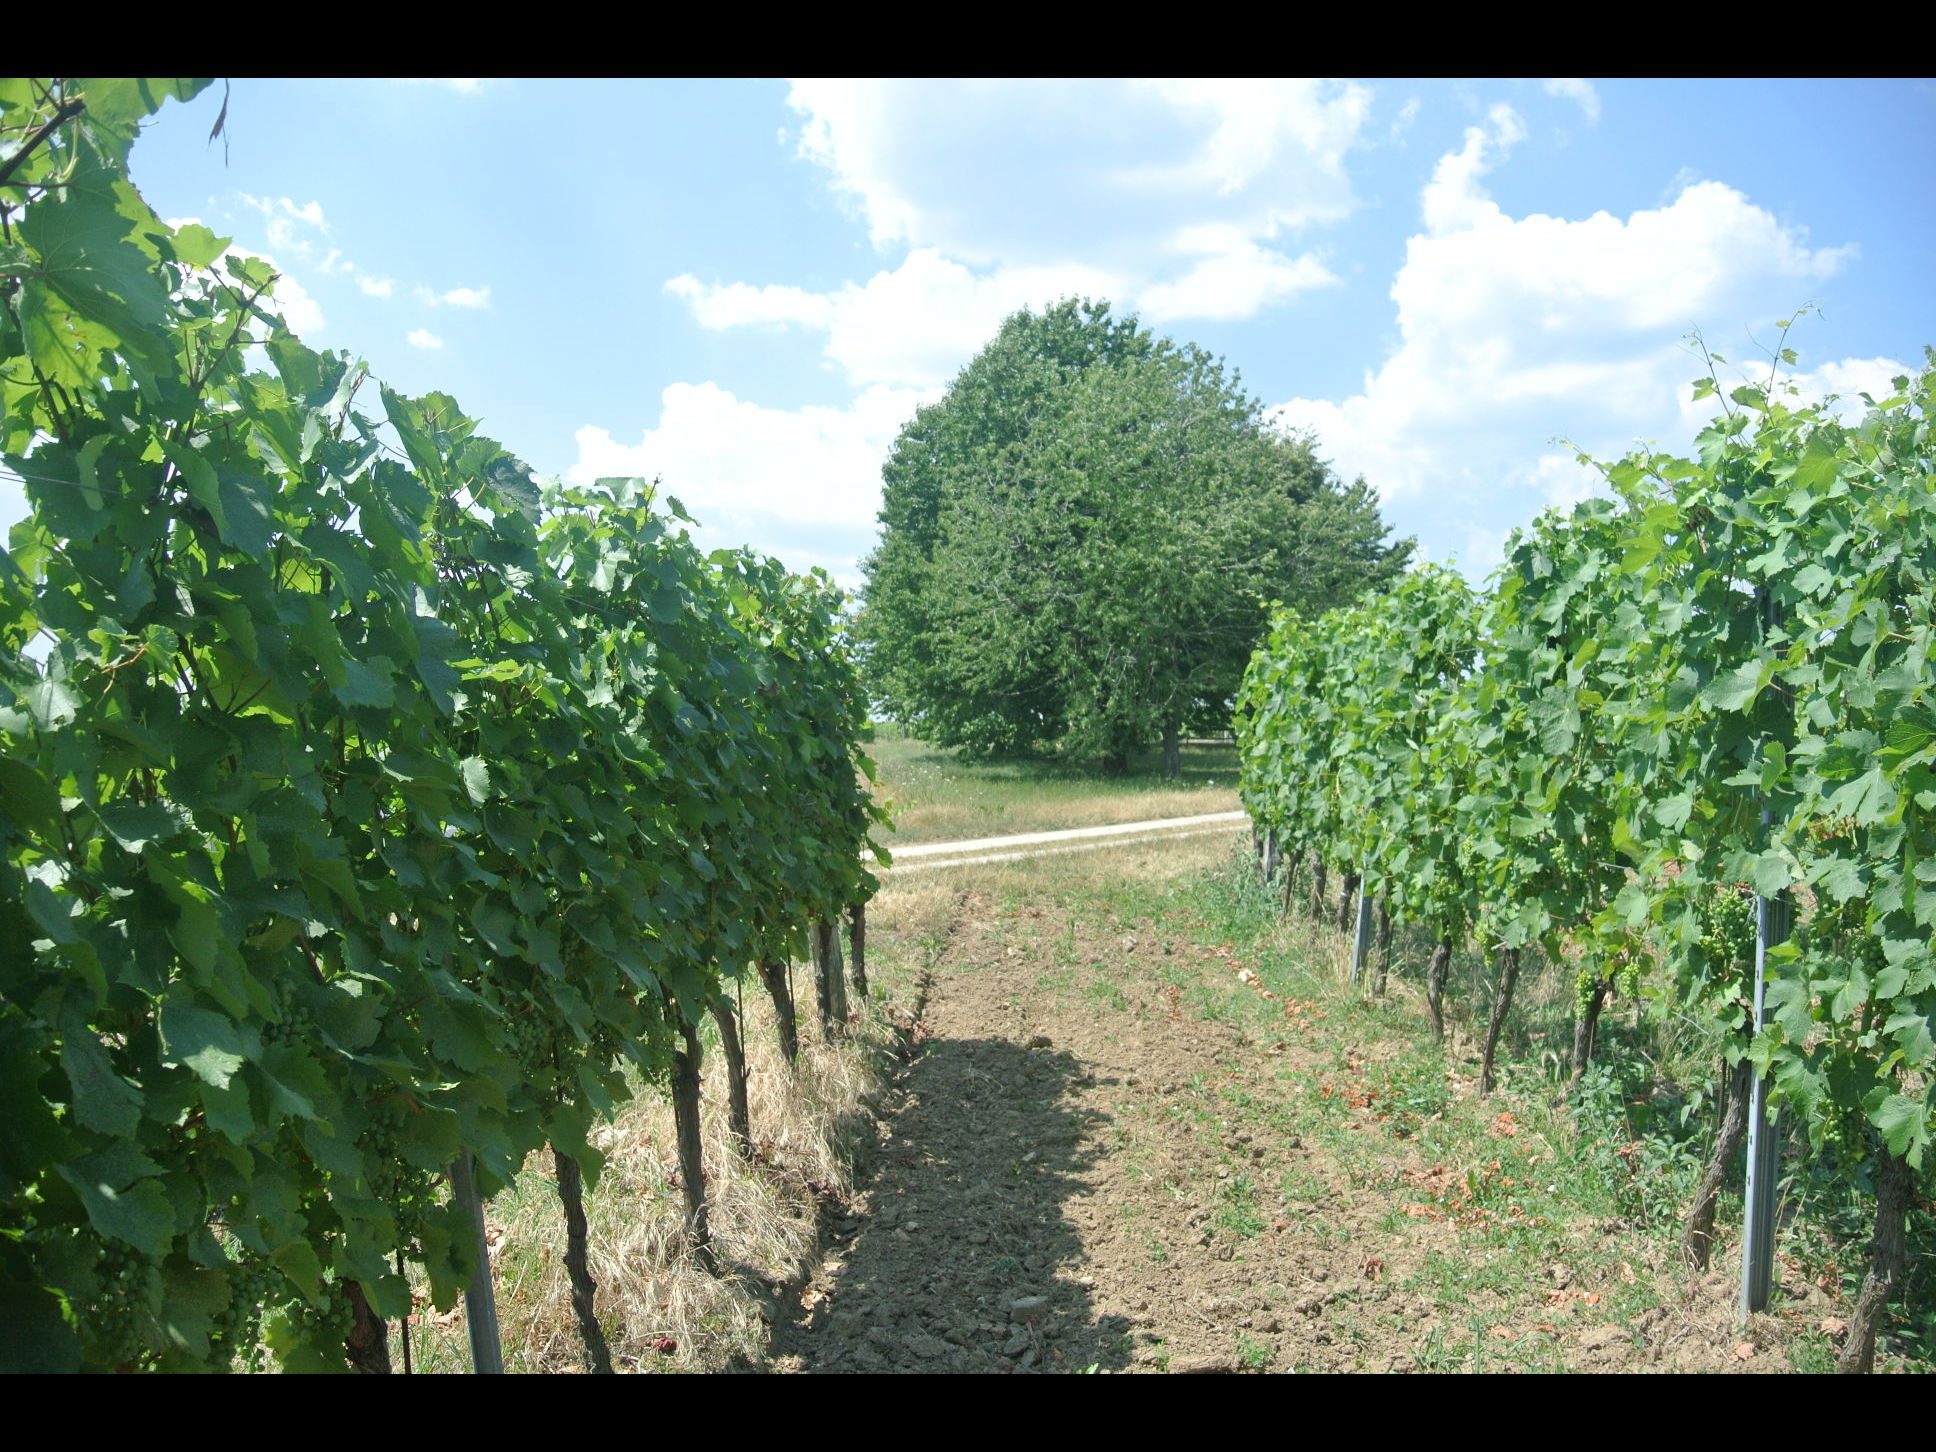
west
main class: Cropland
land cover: Vineyards
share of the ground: 25 - 50 %
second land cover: Other bare soil
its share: > 75 %
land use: Agriculture (excluding fallow land and kitchen gardens)
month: July
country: AT
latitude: 47.5768
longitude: 16.5584
